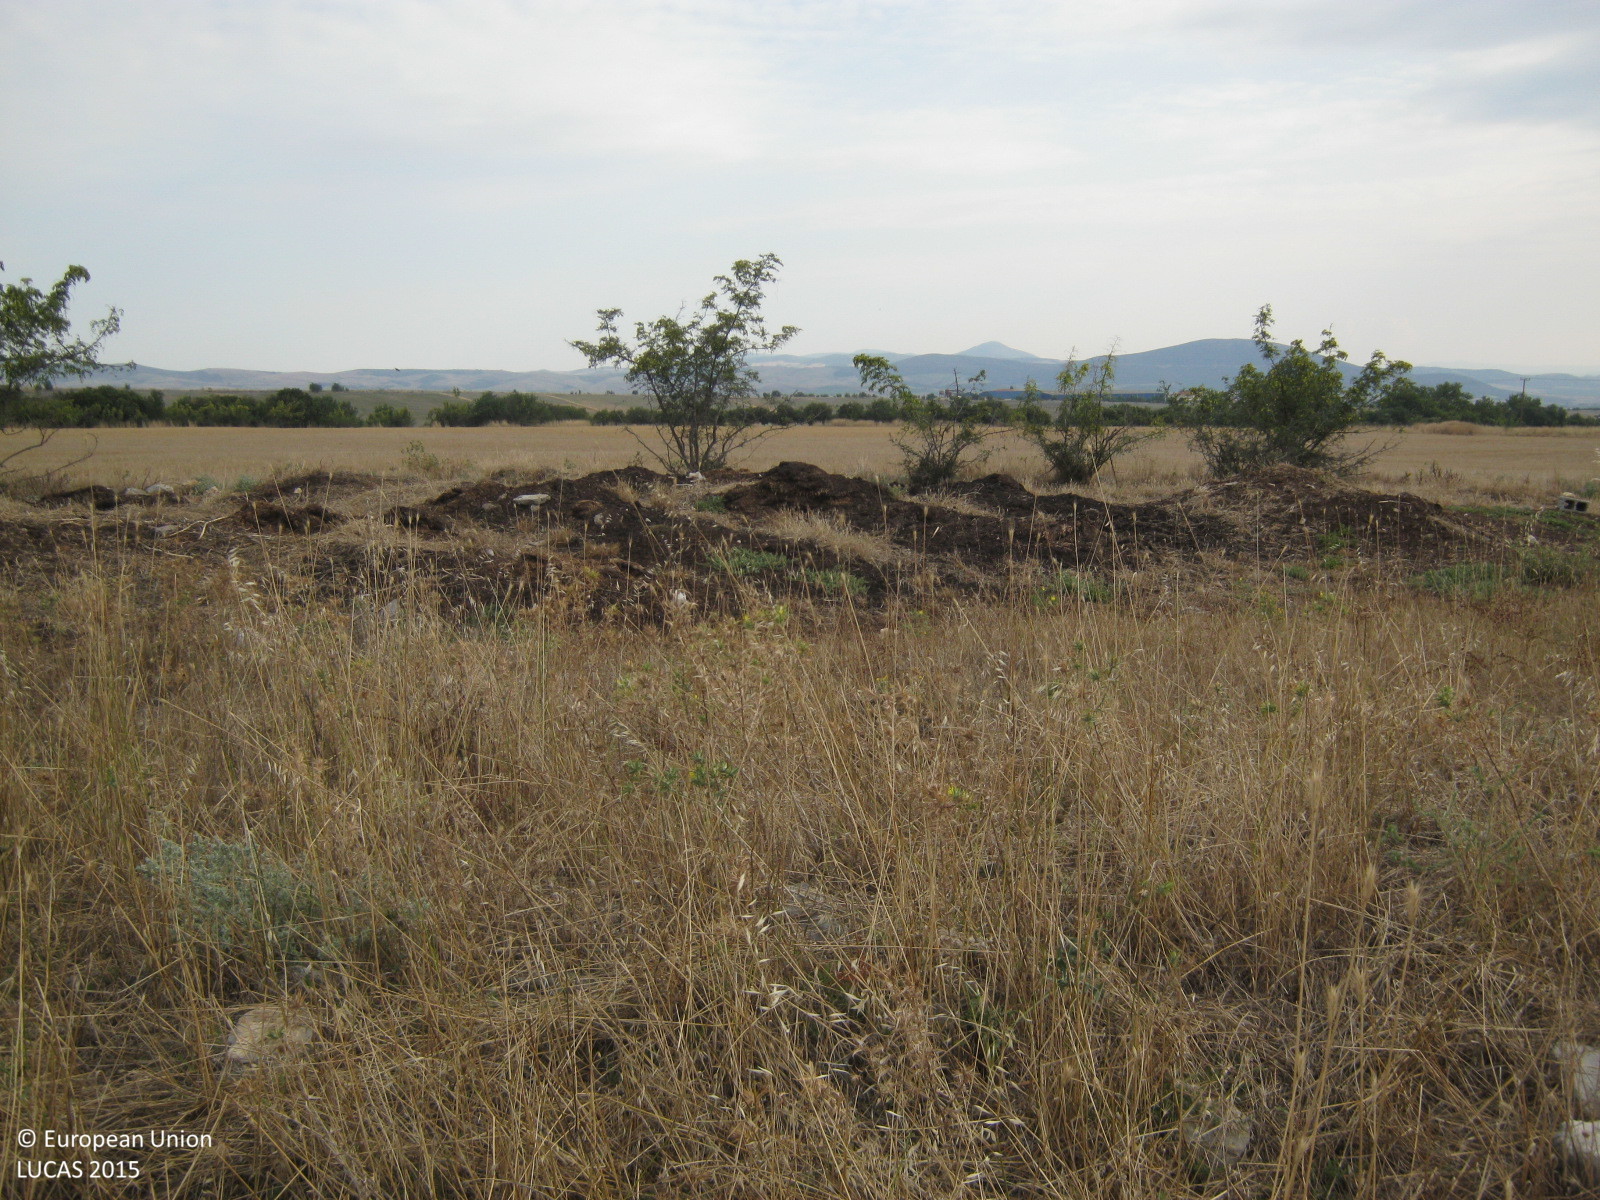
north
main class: Grassland
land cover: Grassland without tree/shrub cover
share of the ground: > 75 %
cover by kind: herbaceous plants 100 %
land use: Agriculture (excluding fallow land and kitchen gardens)
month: July
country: GR
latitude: 39.1722
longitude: 22.6372
